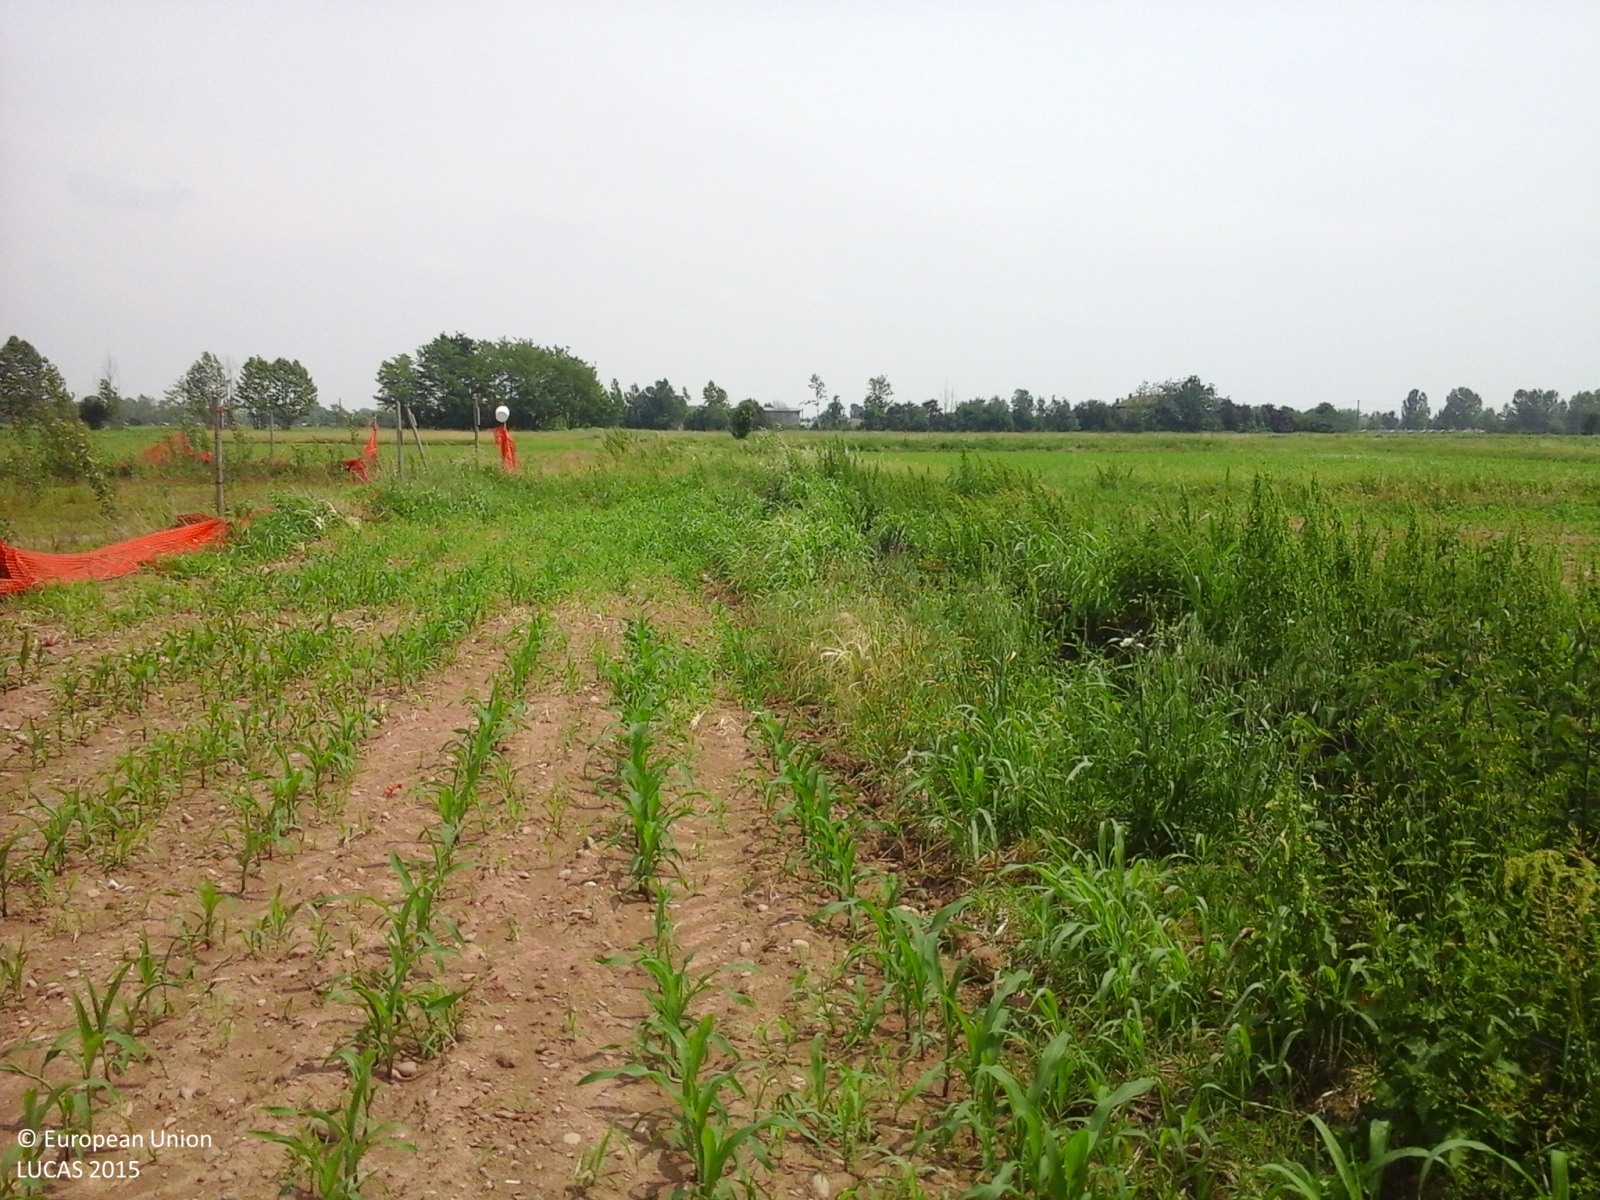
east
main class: Cropland
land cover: Maize
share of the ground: 10 - 25 %
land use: Agriculture (excluding fallow land and kitchen gardens)
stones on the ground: < 10 %
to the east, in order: Maize; Grass margins; Ditches and canals; Grass margins; Maize; Grassland without tree/shrub cover; Barley; Grass margins; Ditches and canals; Grass margins; Tracks; Grass margins; Temporary grasslands
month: May
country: IT
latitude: 45.5397
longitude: 9.6037
